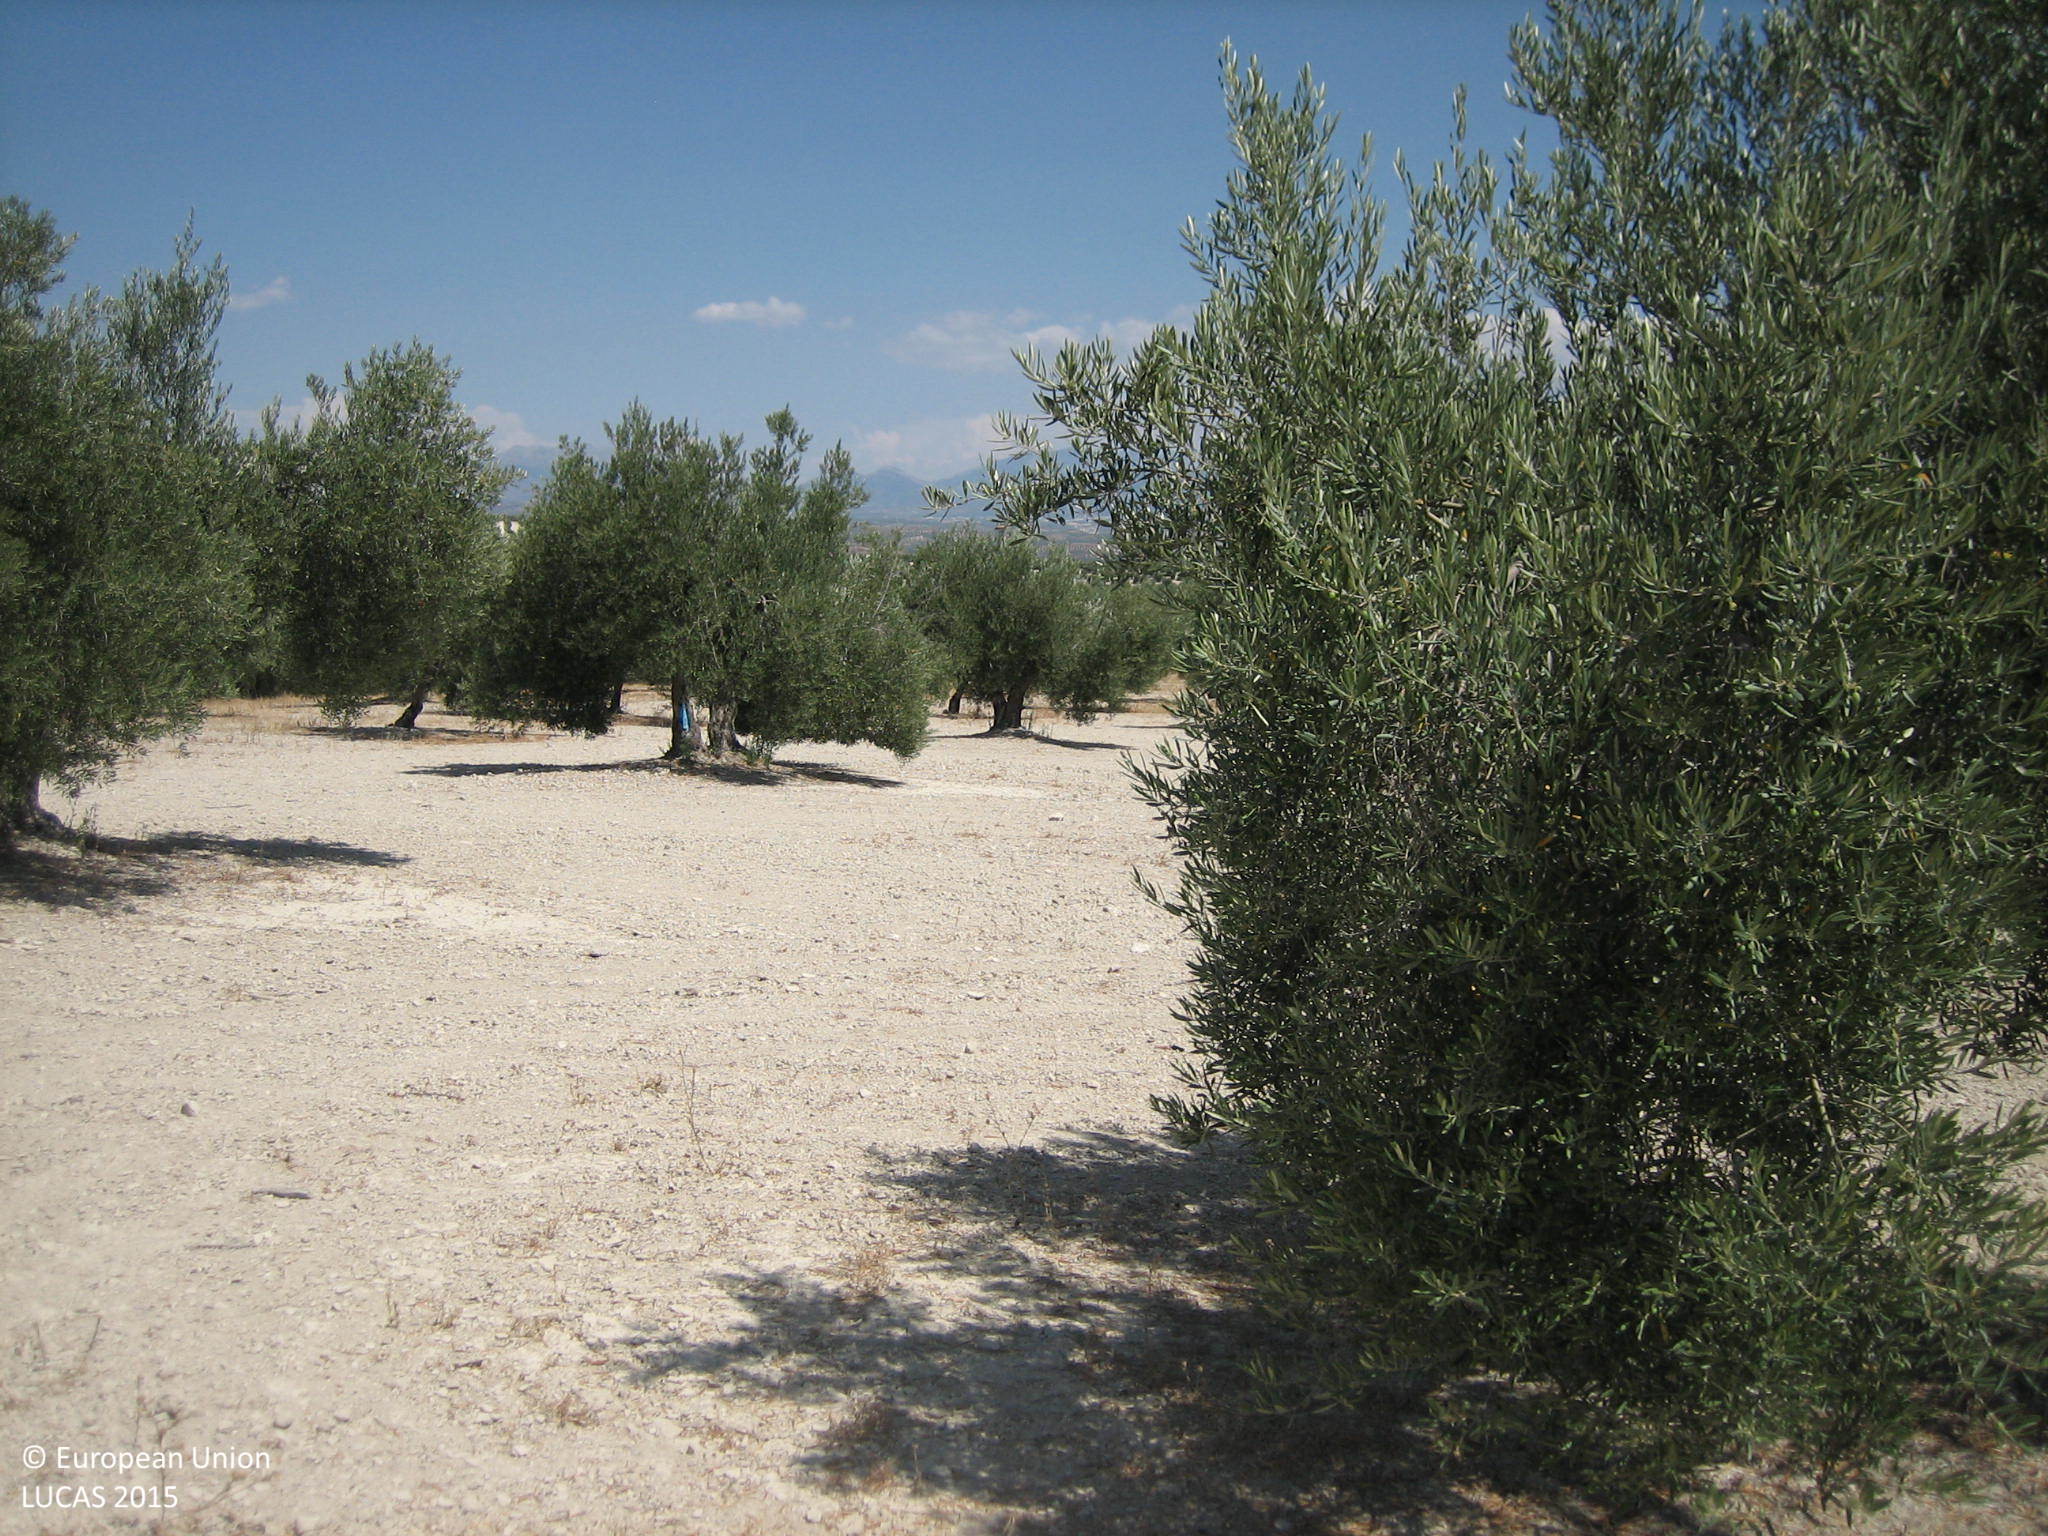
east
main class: Cropland
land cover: Olive groves
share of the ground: 10 - 25 %
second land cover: Other bare soil
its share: > 75 %
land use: Agriculture (excluding fallow land and kitchen gardens)
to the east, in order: Olive groves; Other bare soil
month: June
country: ES
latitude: 37.8579
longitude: -3.7890
